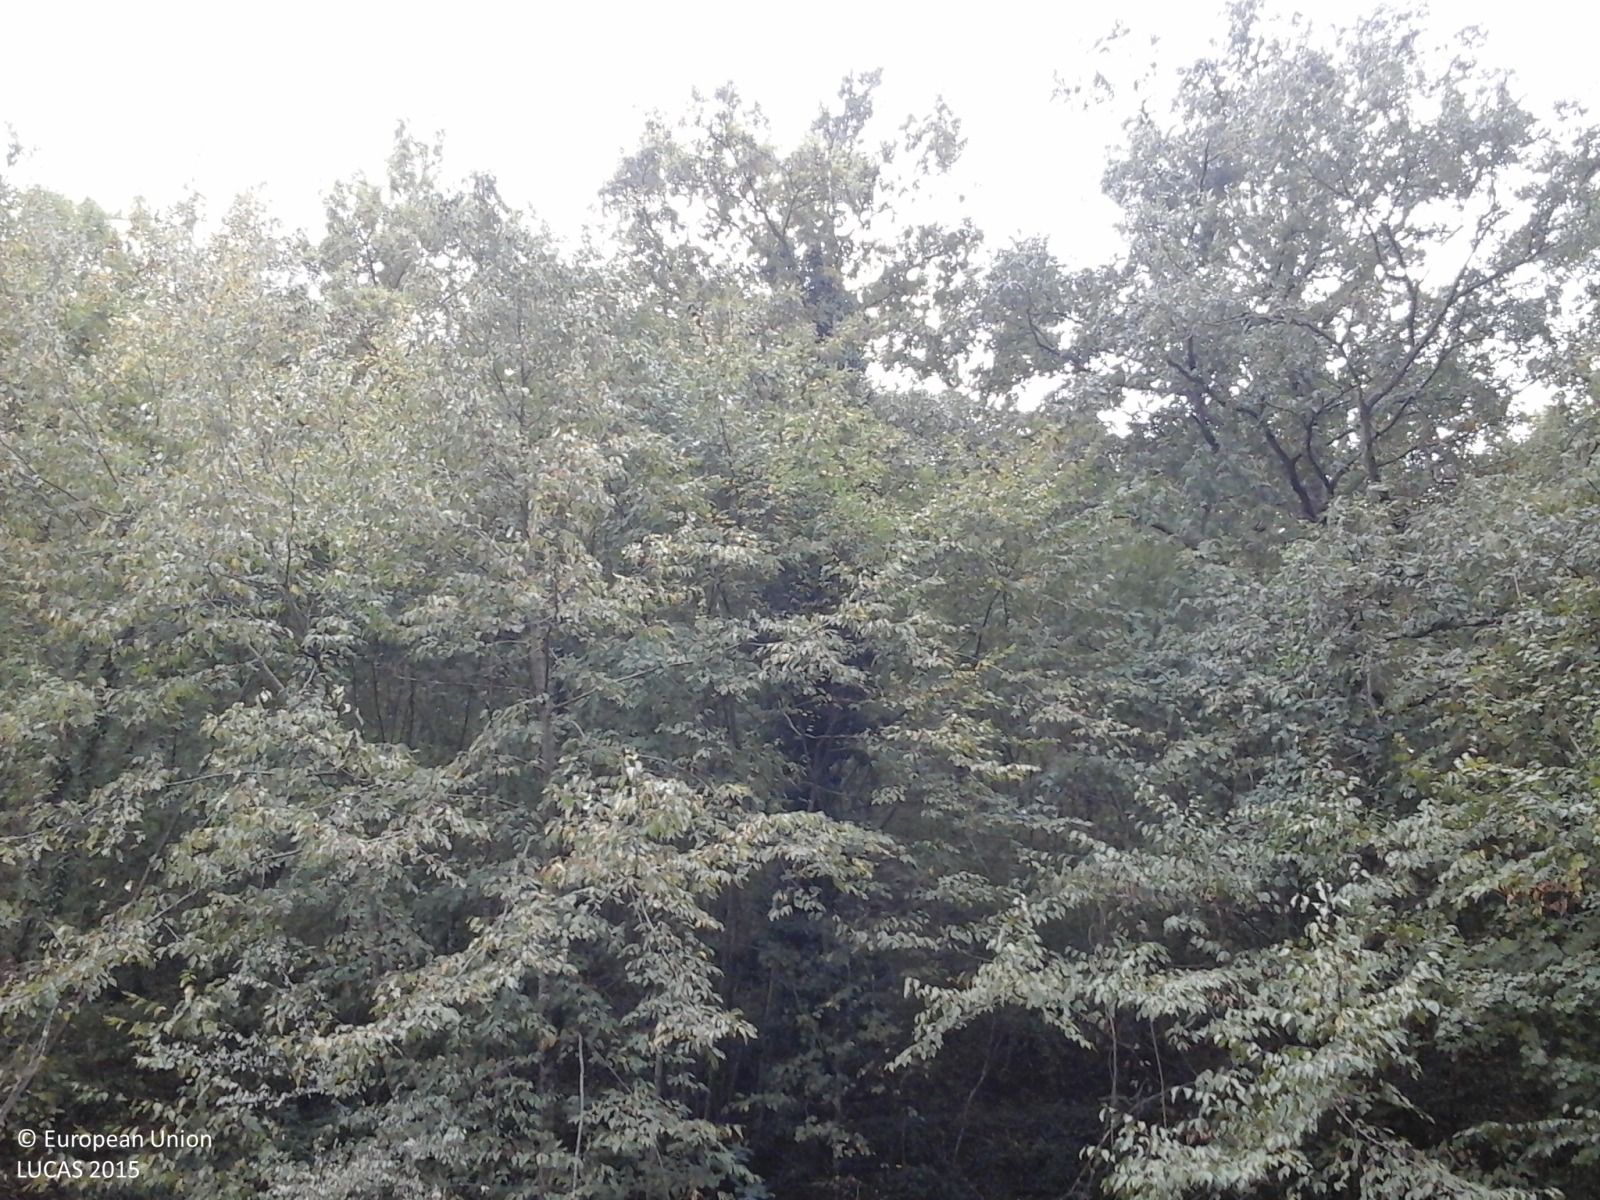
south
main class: Woodland
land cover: Broadleaved woodland
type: thermophilous deciduous forest
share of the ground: > 75 %
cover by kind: broadleaved forest trees 85 %, shrubs 10 %, herbaceous plants 5 %
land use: Forestry
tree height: > 5 m
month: October
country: IT
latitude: 43.1863
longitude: 12.3679
